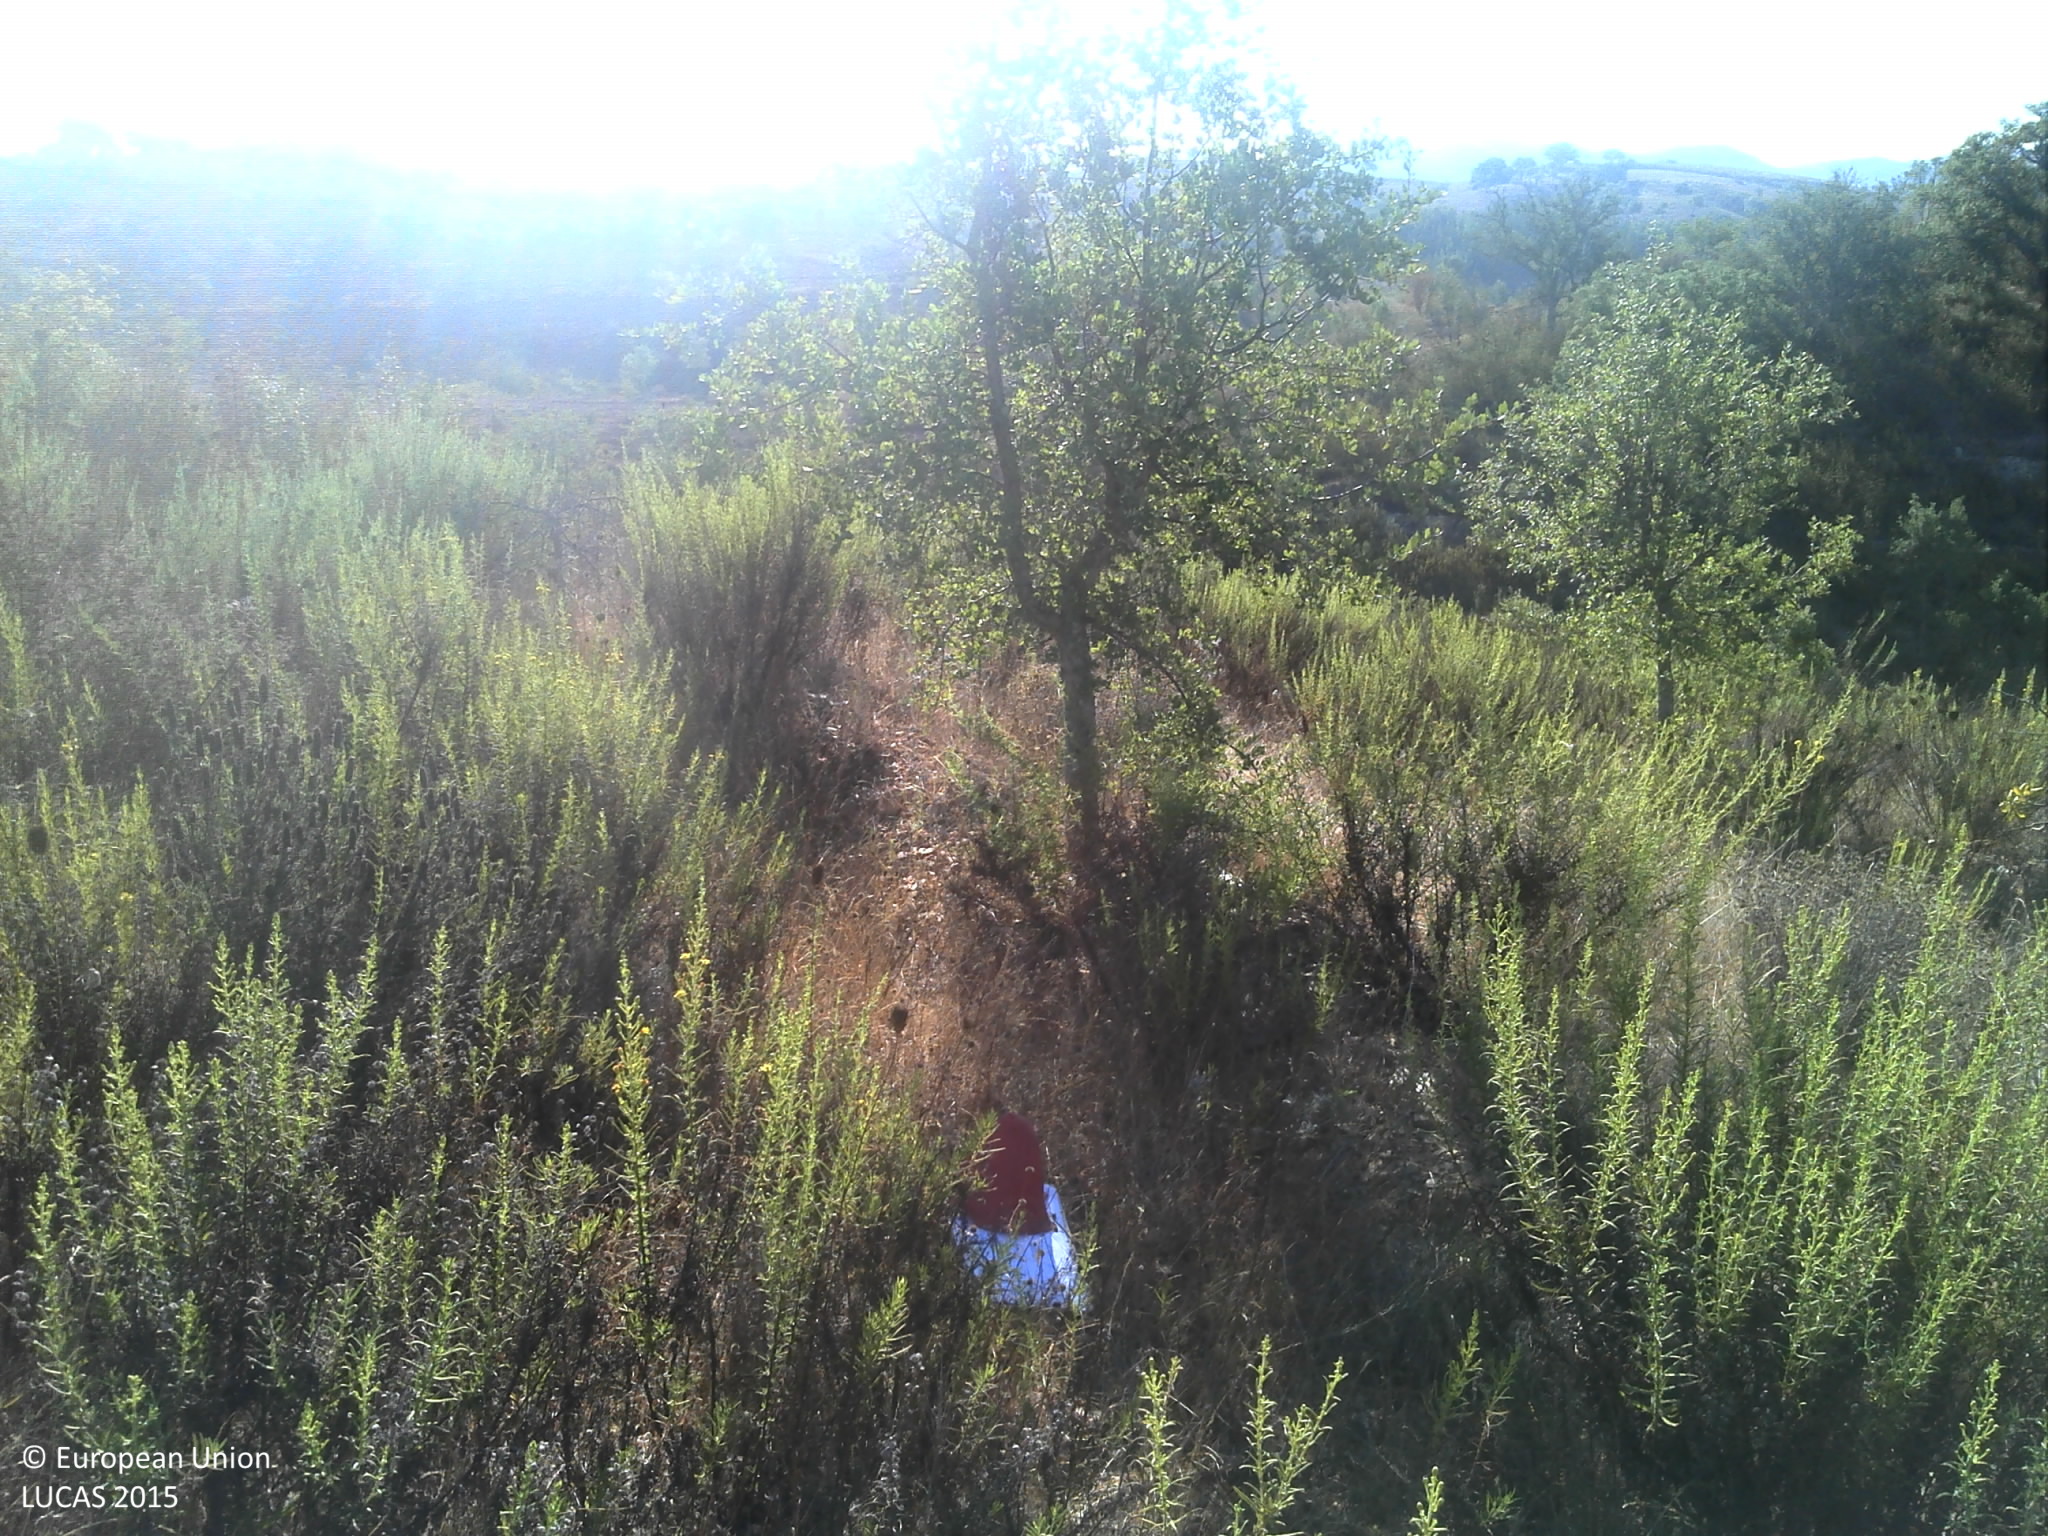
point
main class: Woodland
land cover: Broadleaved woodland
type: broadleaved evergreen forest
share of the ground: 10 - 25 %
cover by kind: shrubs 40 %, unconsolidated bare surface 35 %, broadleaved forest trees 25 %
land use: Forestry
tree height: < 5 m
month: August
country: PT
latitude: 37.5912
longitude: -8.4597
